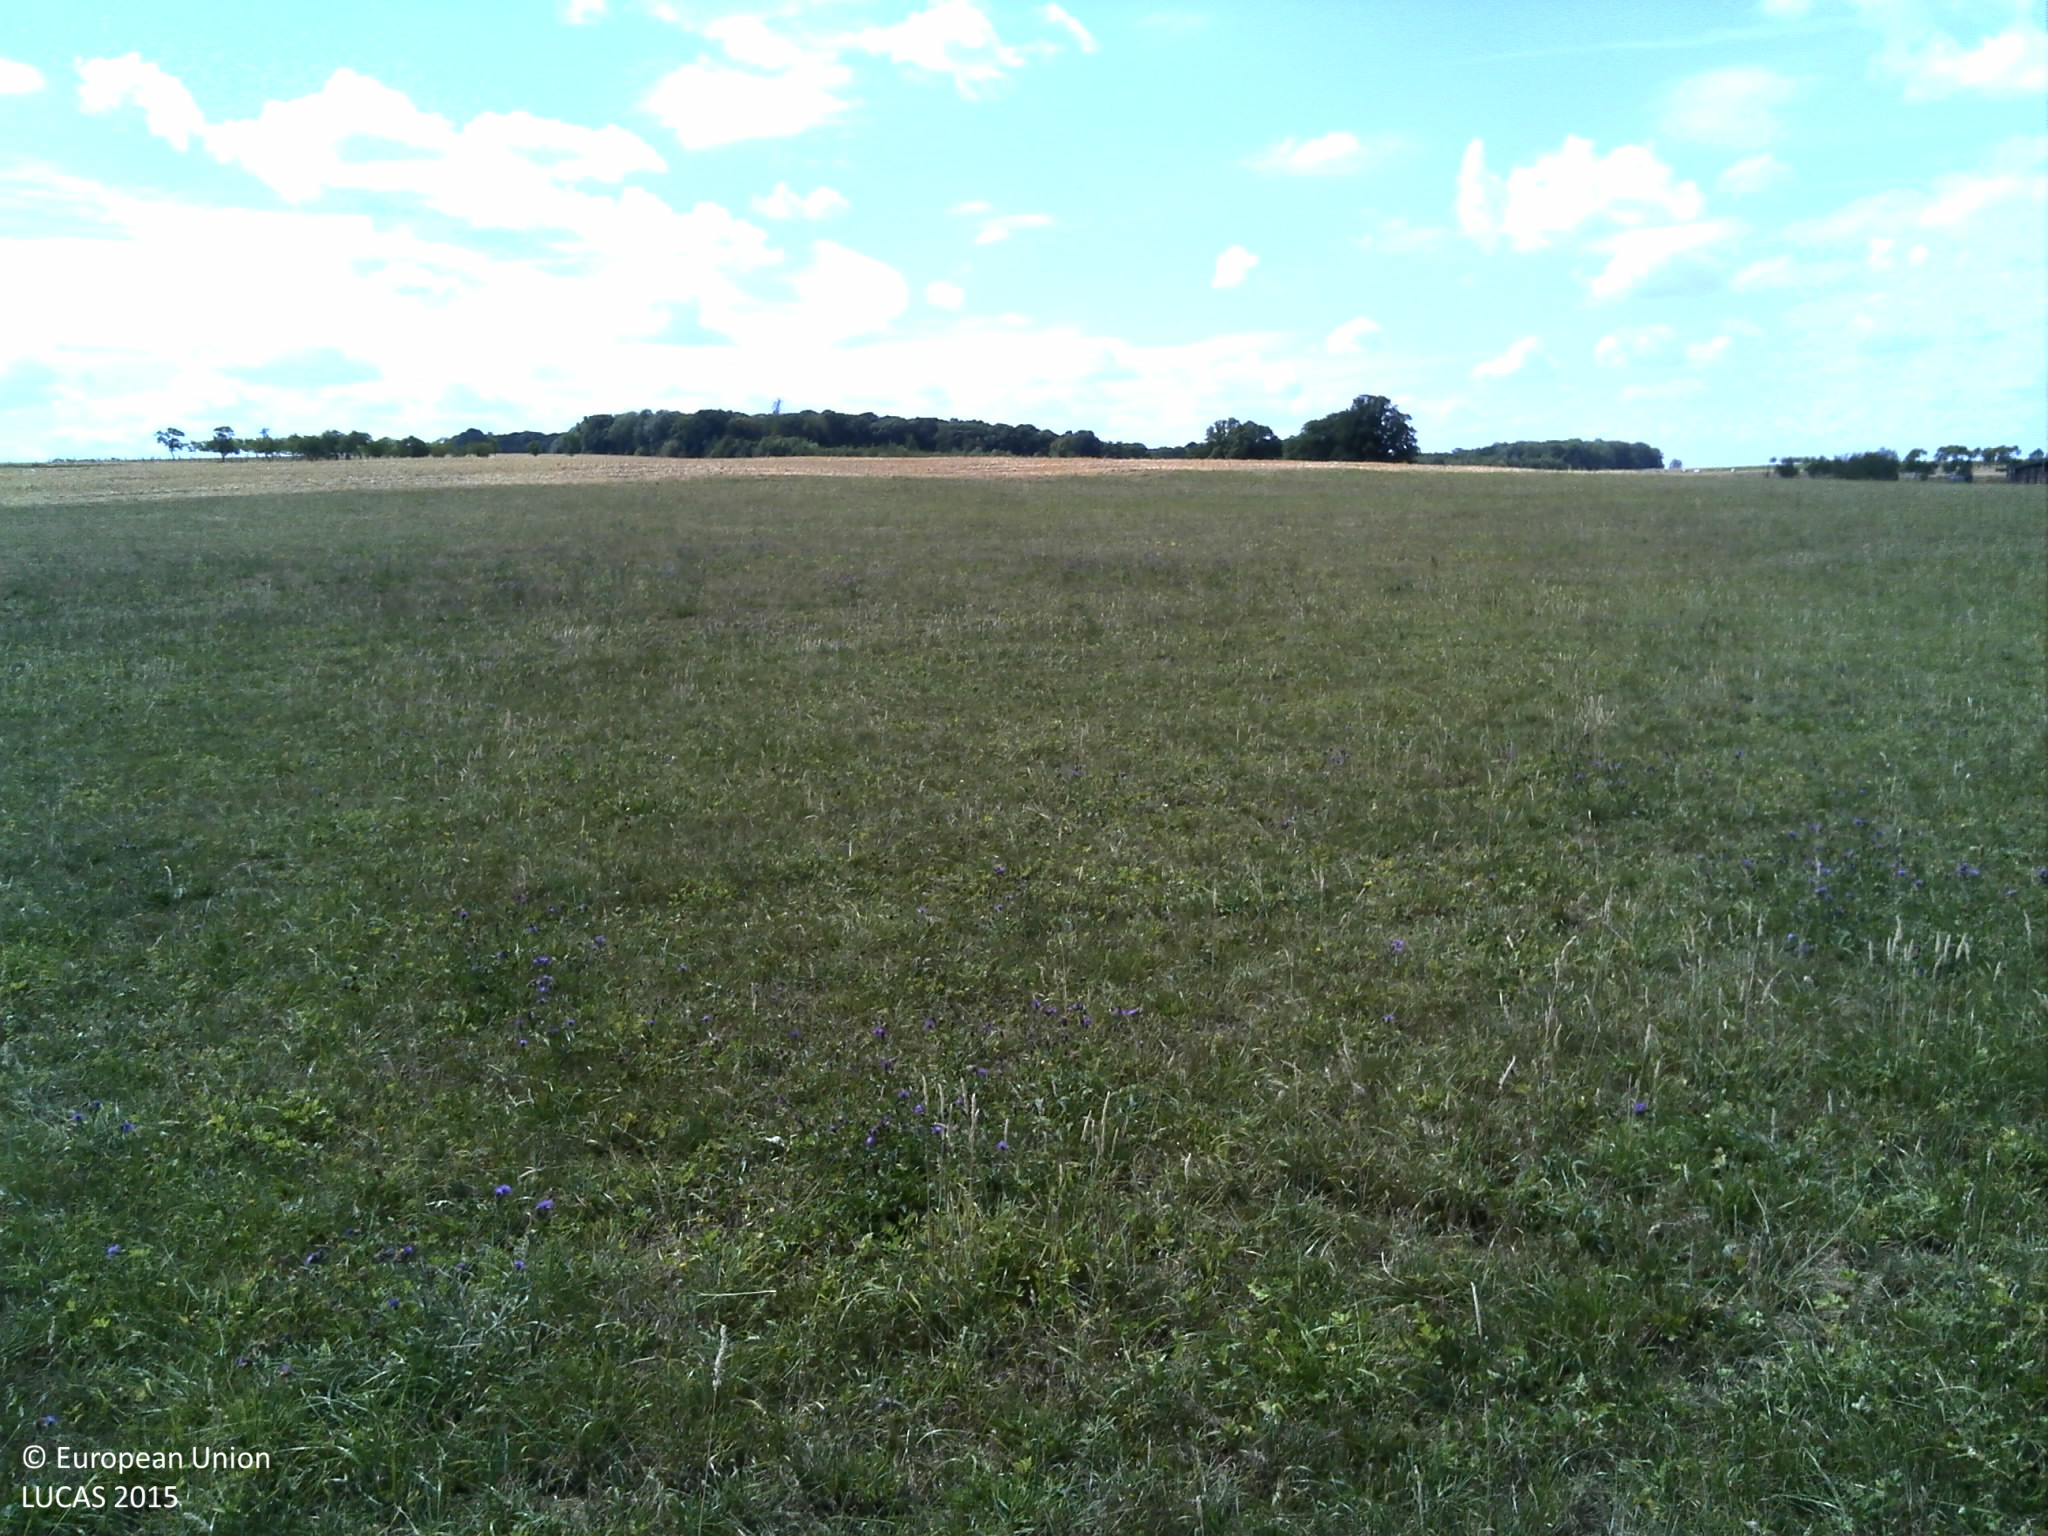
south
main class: Grassland
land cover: Grassland without tree/shrub cover
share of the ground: > 75 %
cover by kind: herbaceous plants 100 %
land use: Agriculture (excluding fallow land and kitchen gardens)
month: July
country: FR
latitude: 48.3479
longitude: 5.9656
